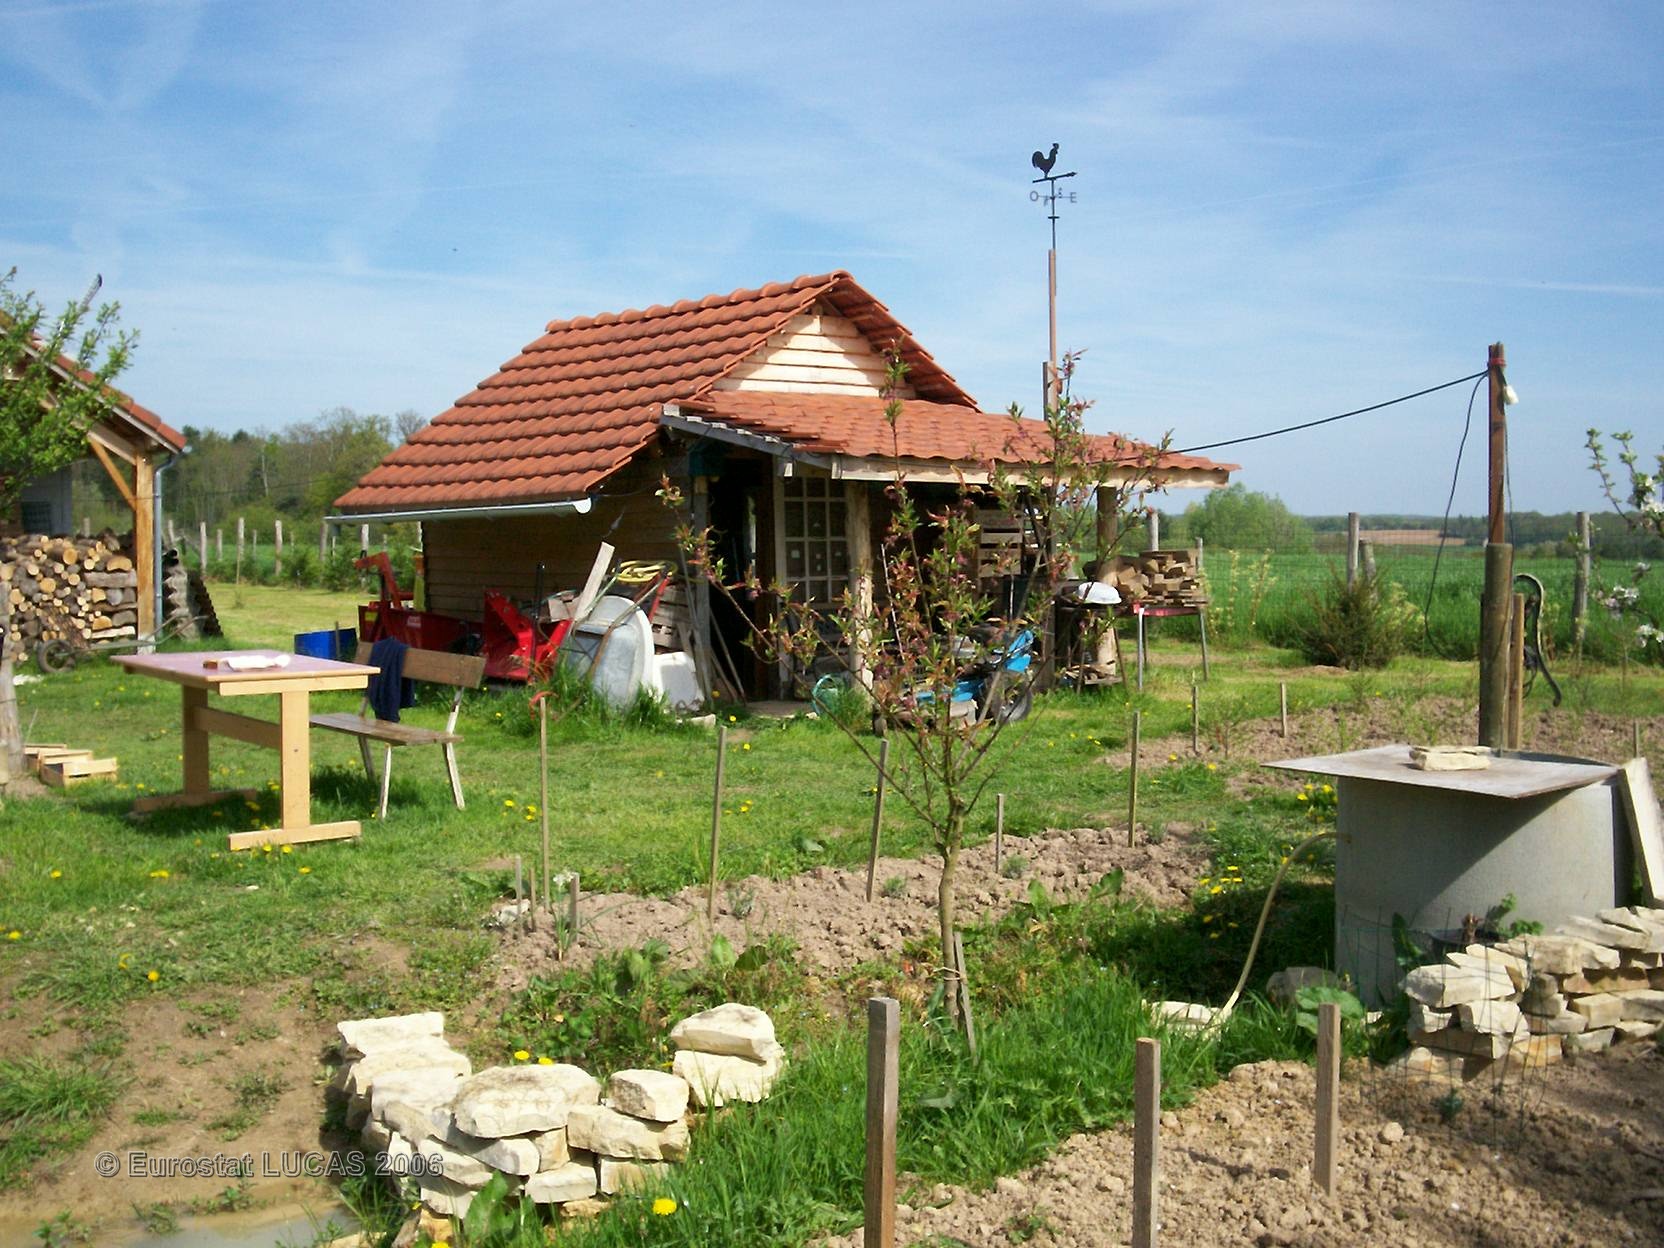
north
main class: Cropland
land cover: Other fruit trees and berries
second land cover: Grassland with sparse tree/shrub cover
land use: Kitchen garden
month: May
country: FR
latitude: 48.0077
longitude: 4.0317
